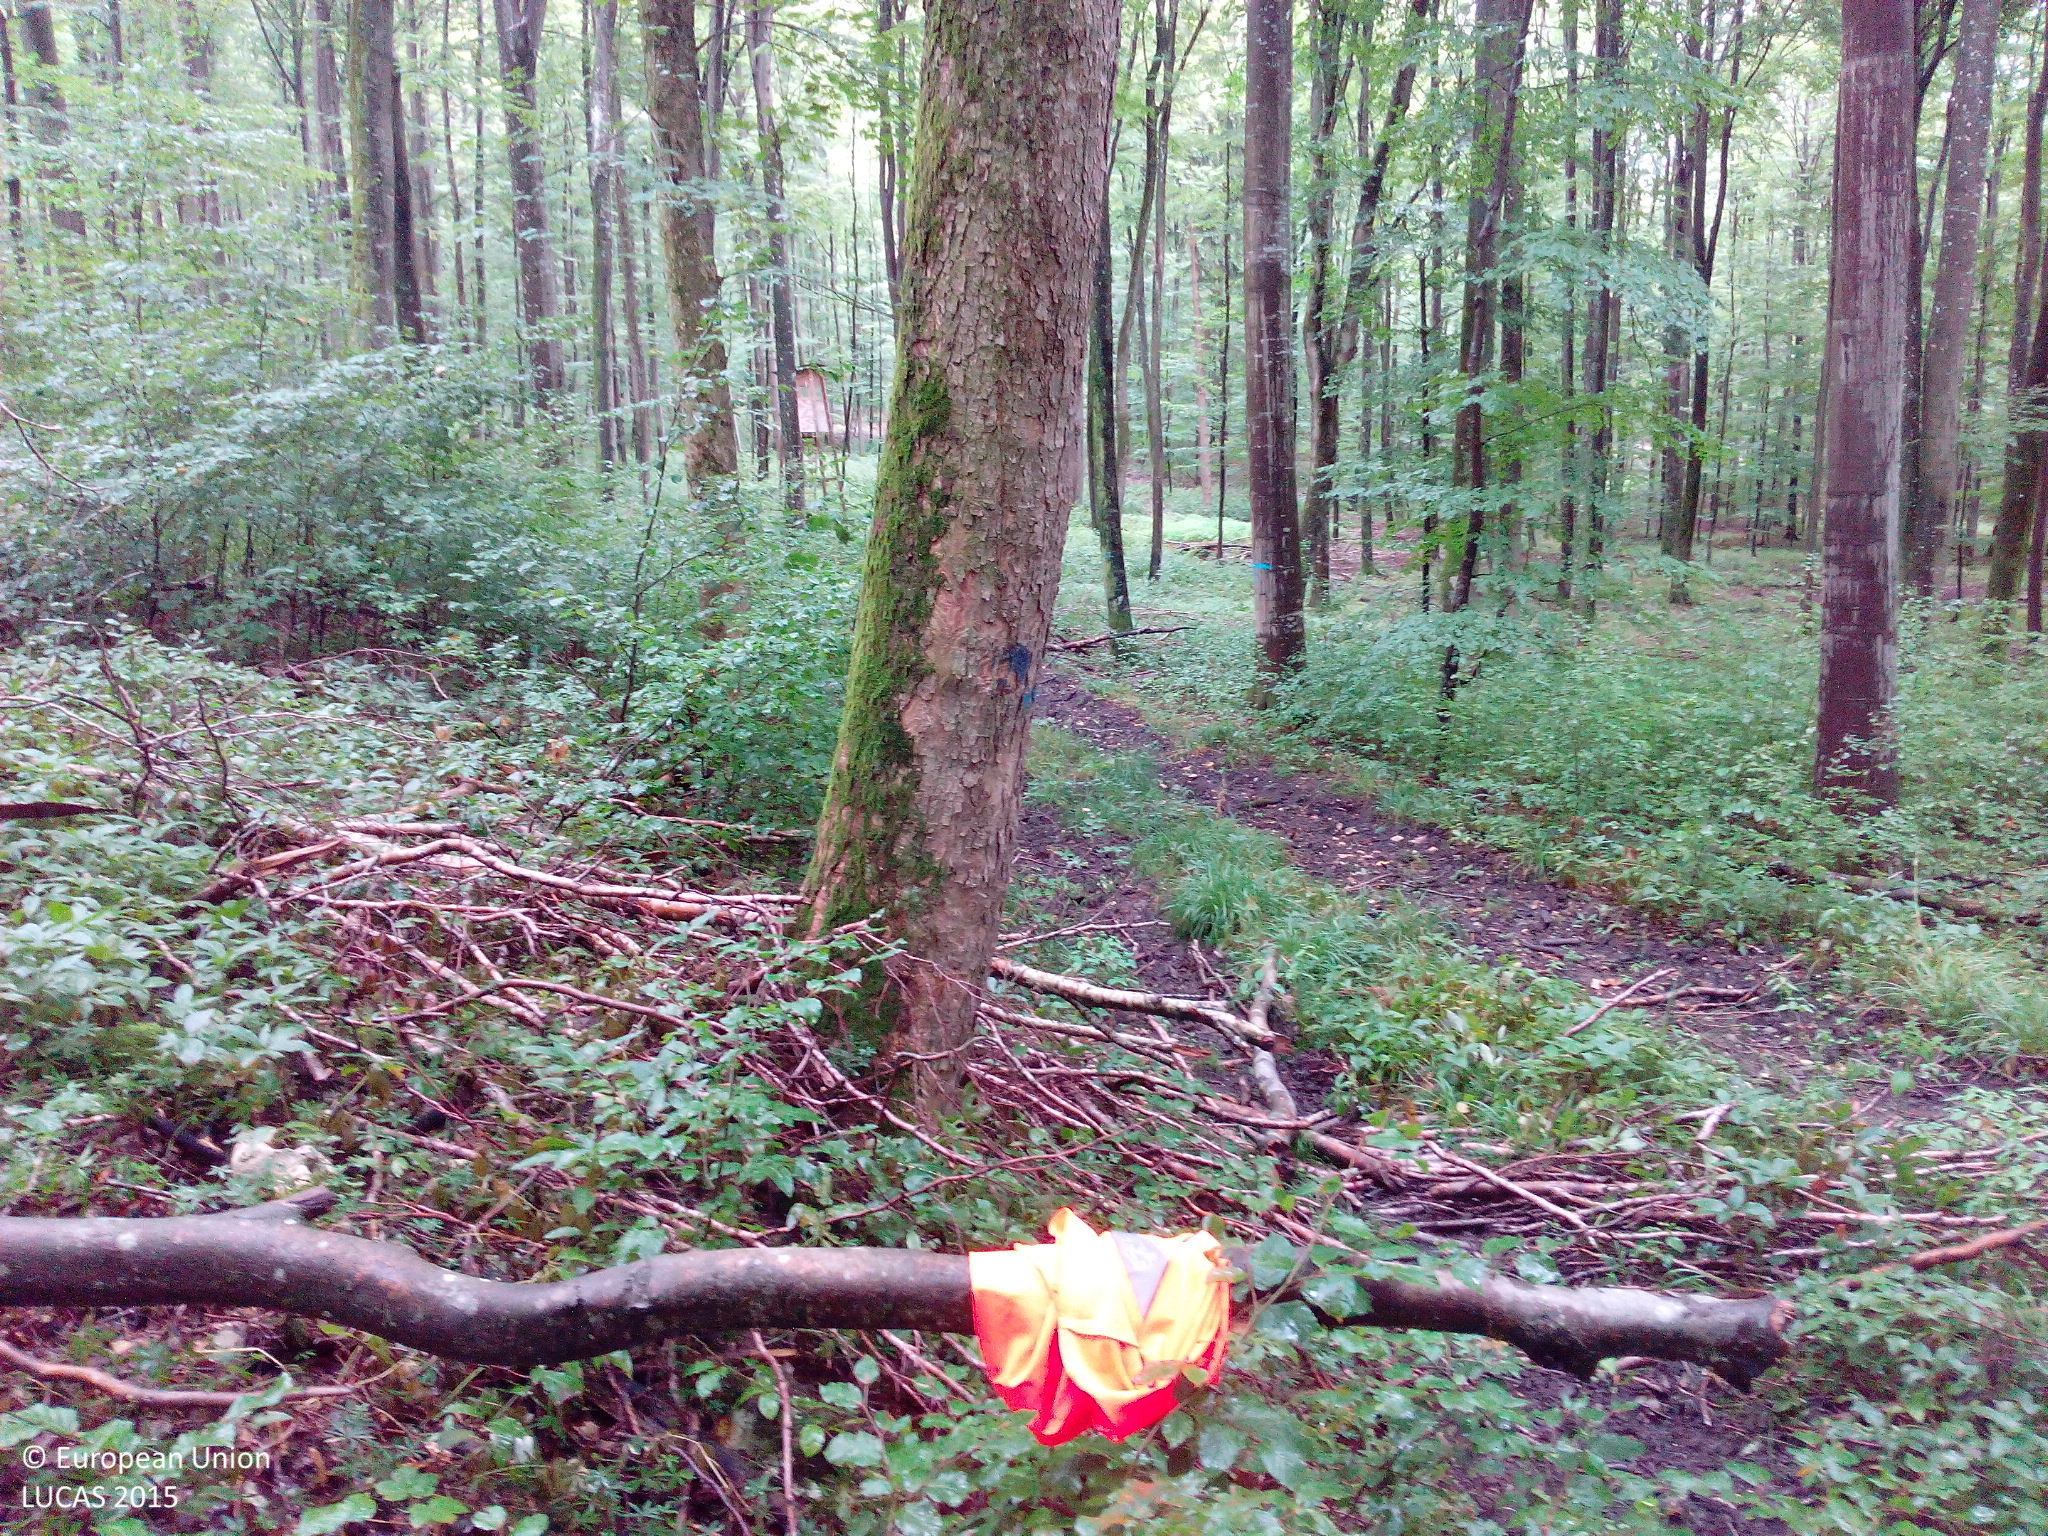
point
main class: Woodland
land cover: Broadleaved woodland
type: mesophytic deciduous forest
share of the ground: > 75 %
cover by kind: broadleaved forest trees 70 %, coniferous forest trees 15 %, shrubs 10 %, unconsolidated bare surface 5 %
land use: Forestry
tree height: > 5 m
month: August
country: DE
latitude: 48.5474
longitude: 9.9594
